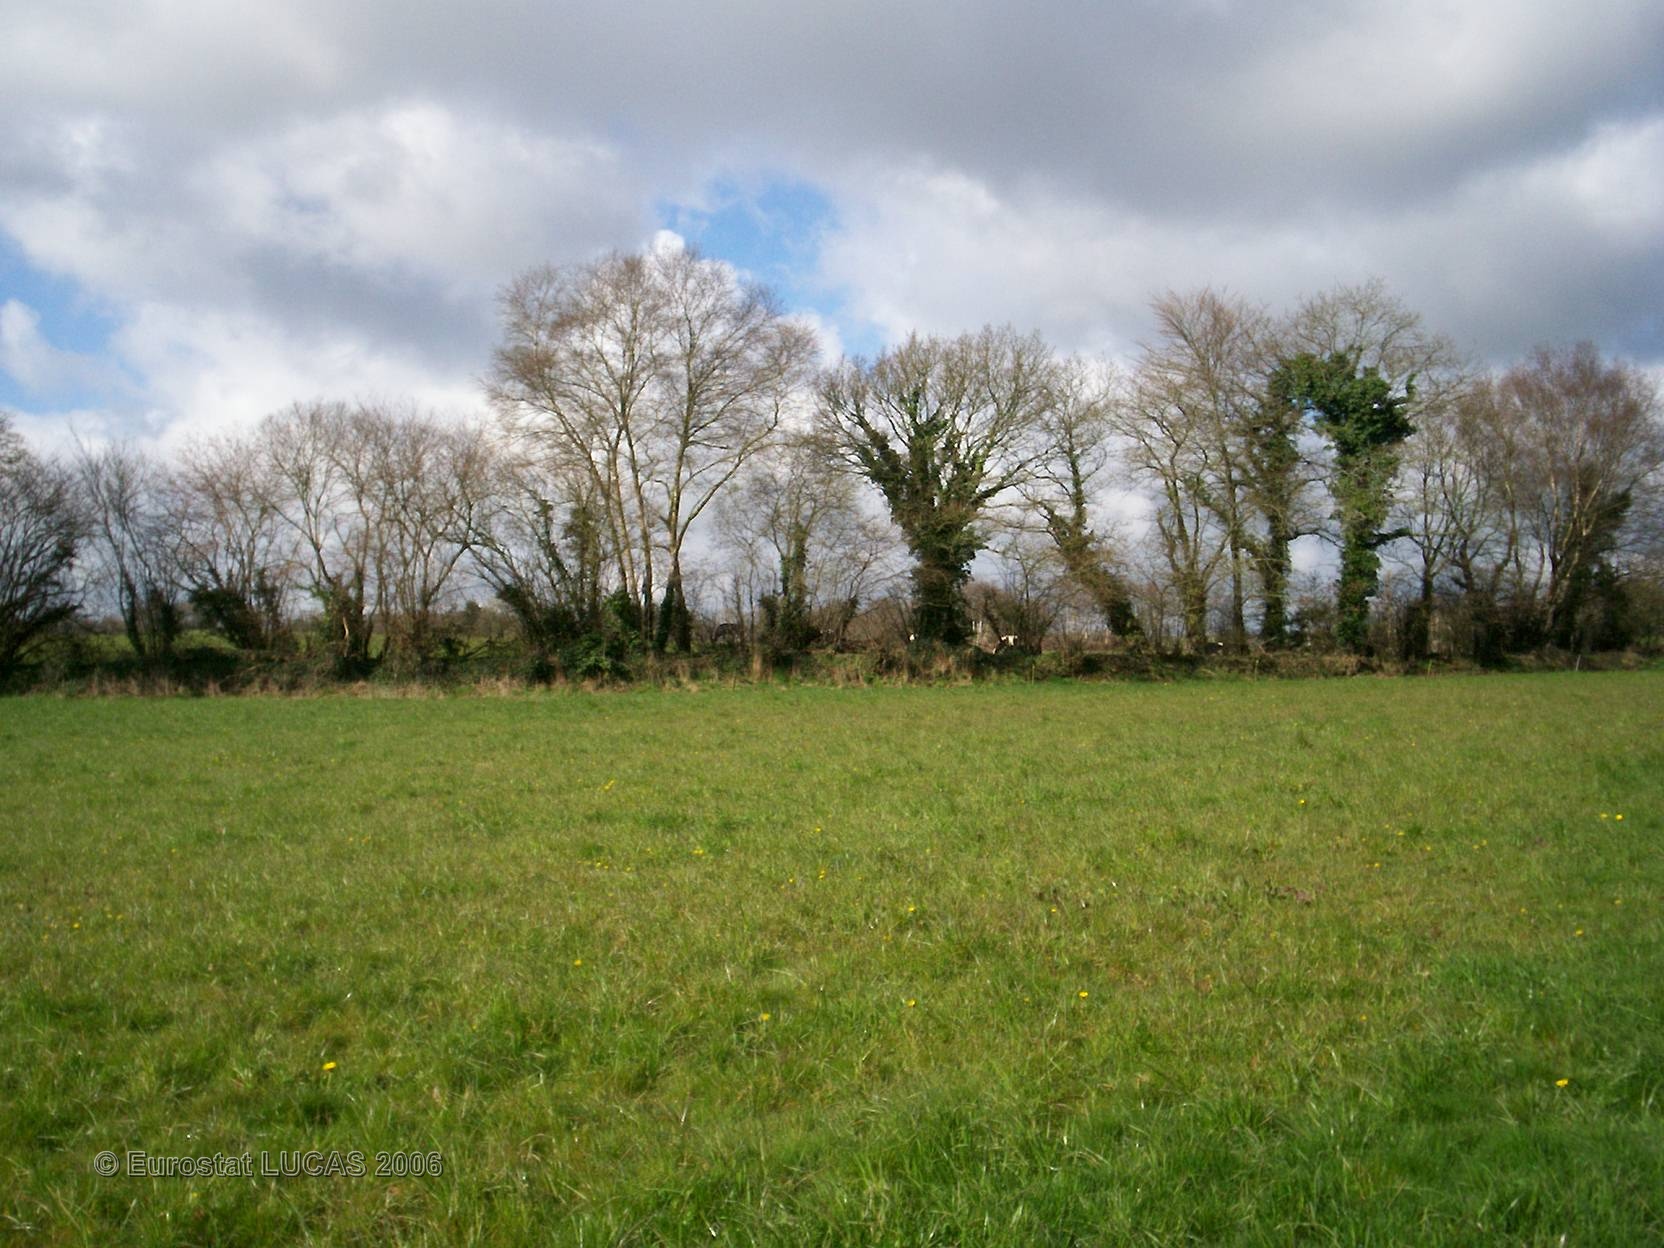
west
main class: Grassland
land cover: Grassland without tree/shrub cover
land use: Agriculture (excluding fallow land and kitchen gardens)
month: April
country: FR
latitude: 48.1340
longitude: -3.6656
